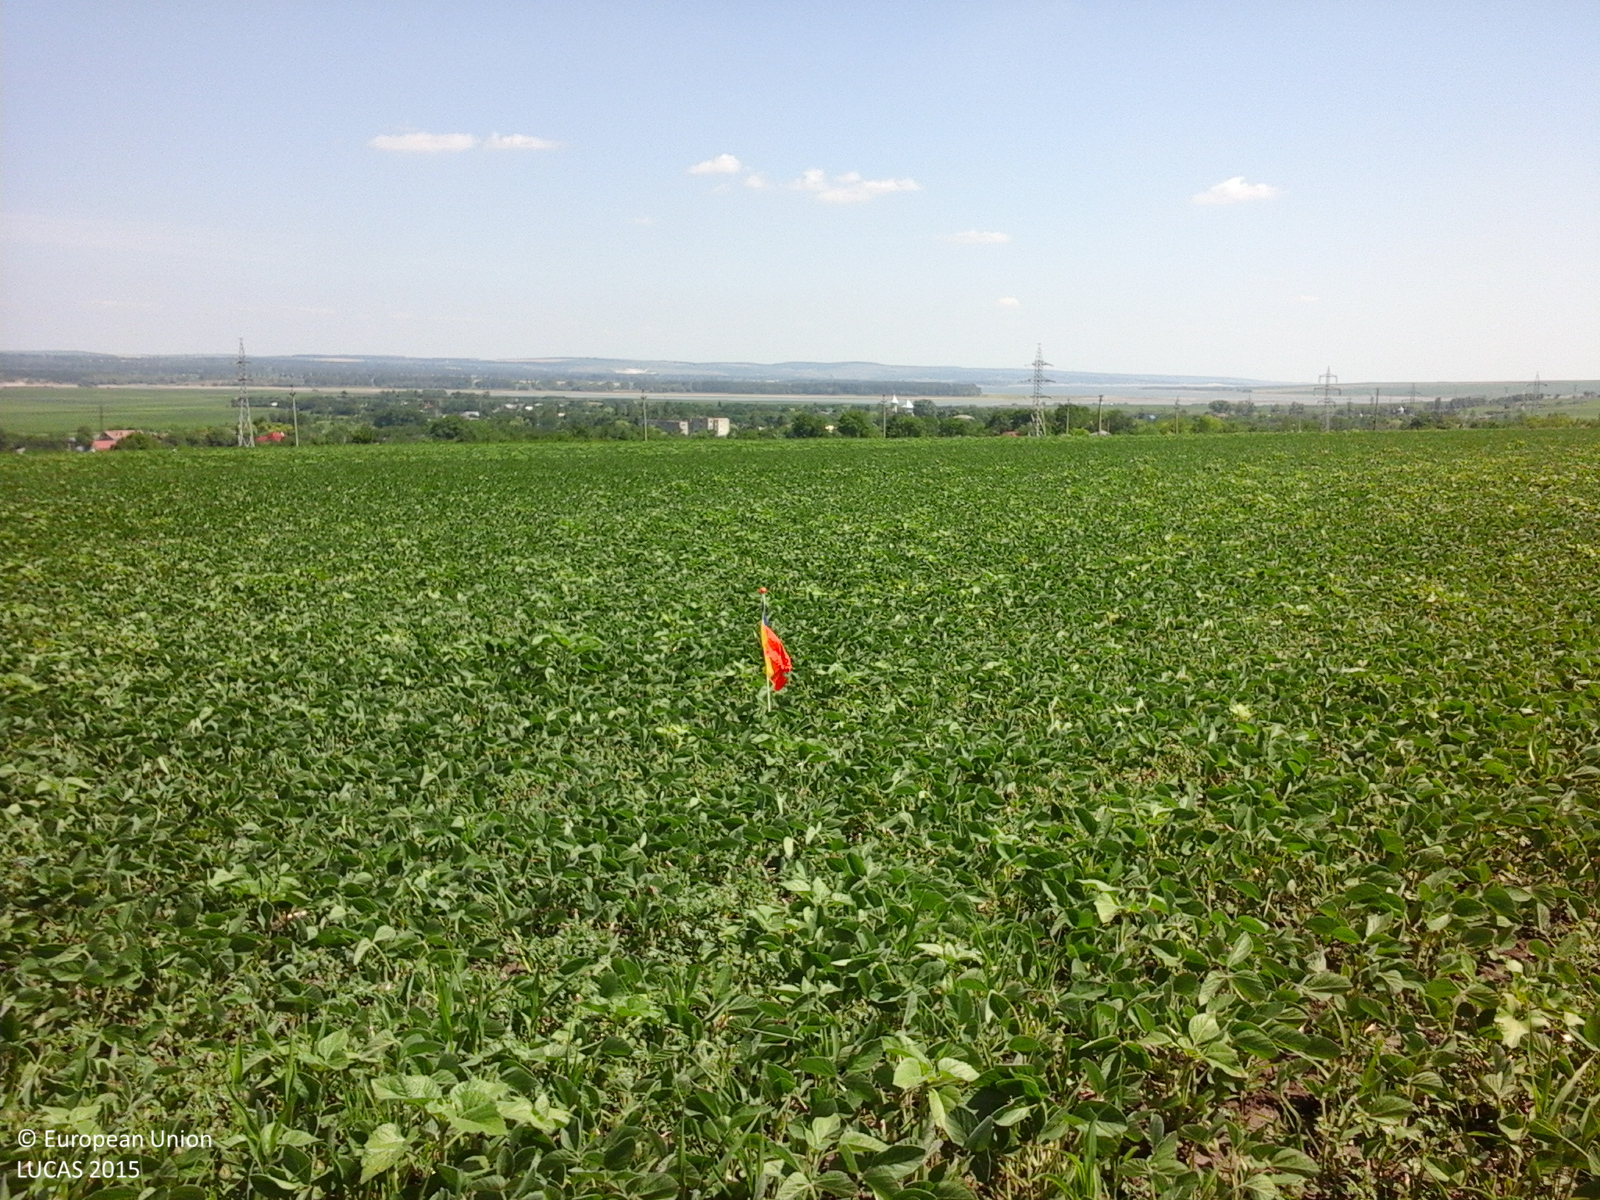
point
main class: Cropland
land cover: Soya
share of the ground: > 75 %
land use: Agriculture (excluding fallow land and kitchen gardens)
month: June
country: RO
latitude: 47.9545
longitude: 27.1298
